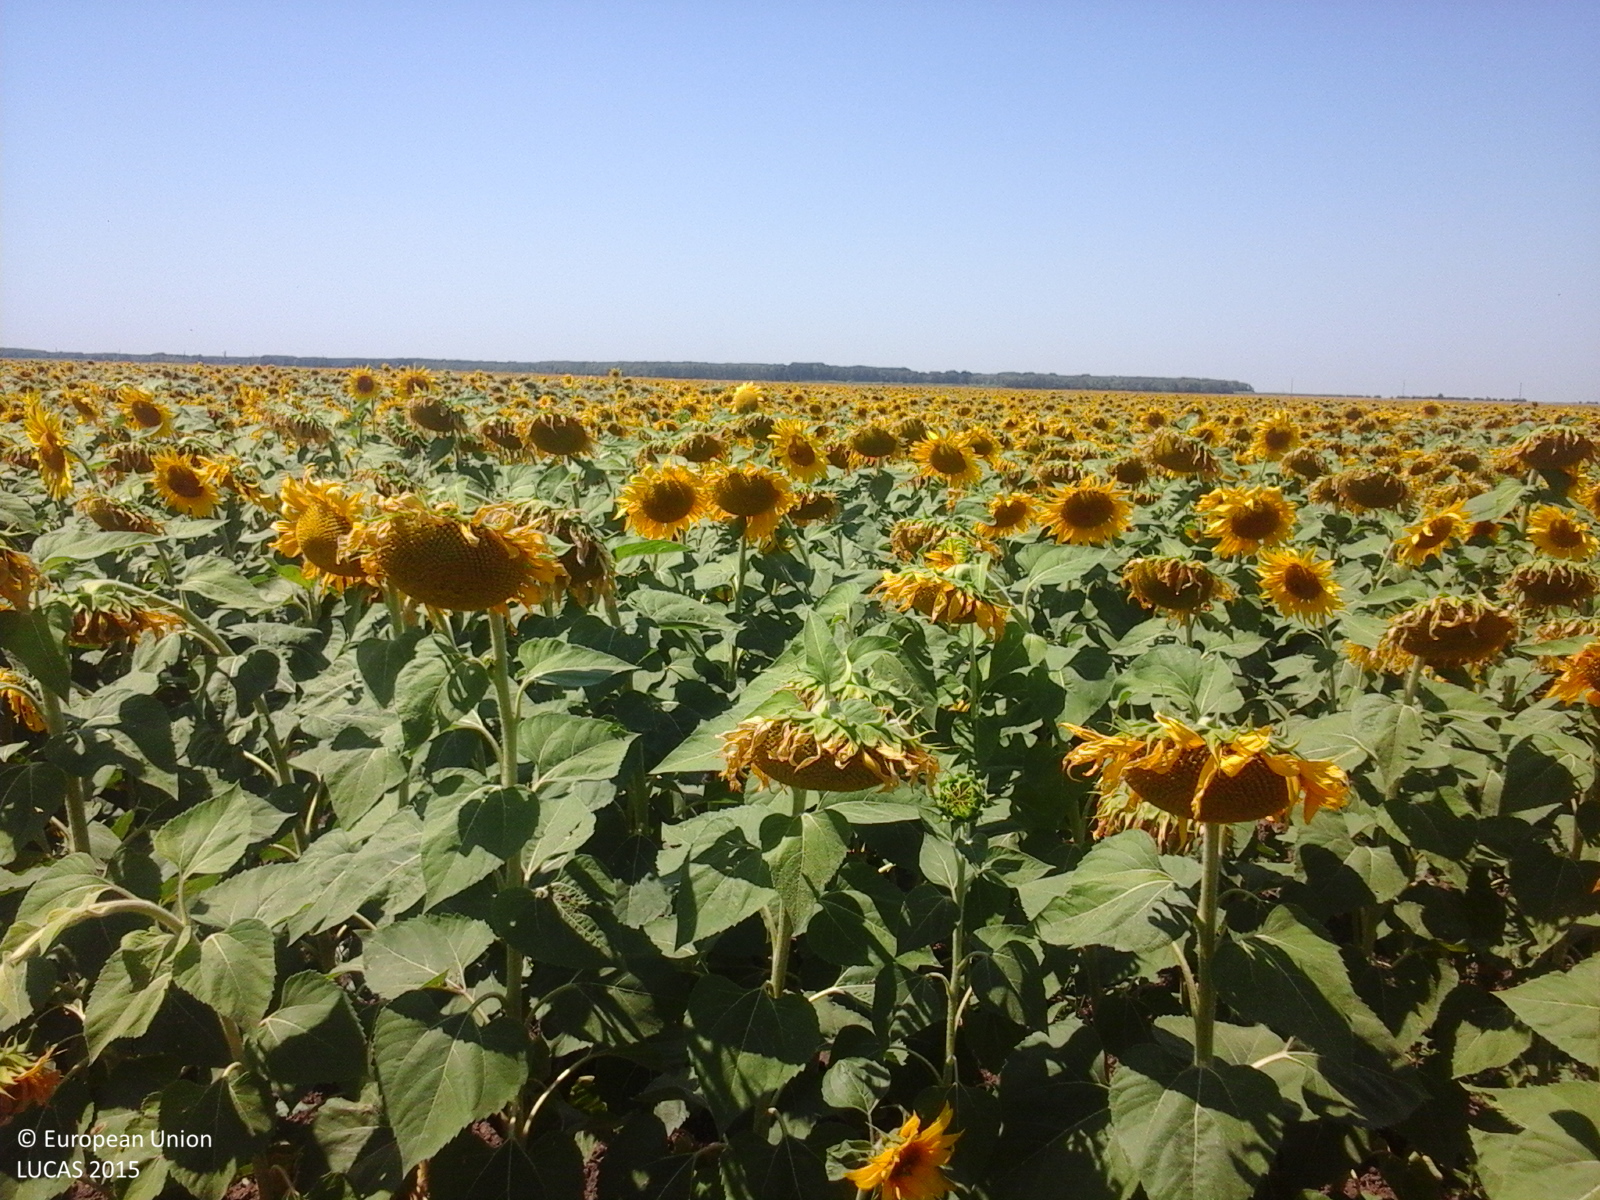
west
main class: Cropland
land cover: Sunflower
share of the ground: > 75 %
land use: Agriculture (excluding fallow land and kitchen gardens)
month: July
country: RO
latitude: 44.2546
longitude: 26.5850
